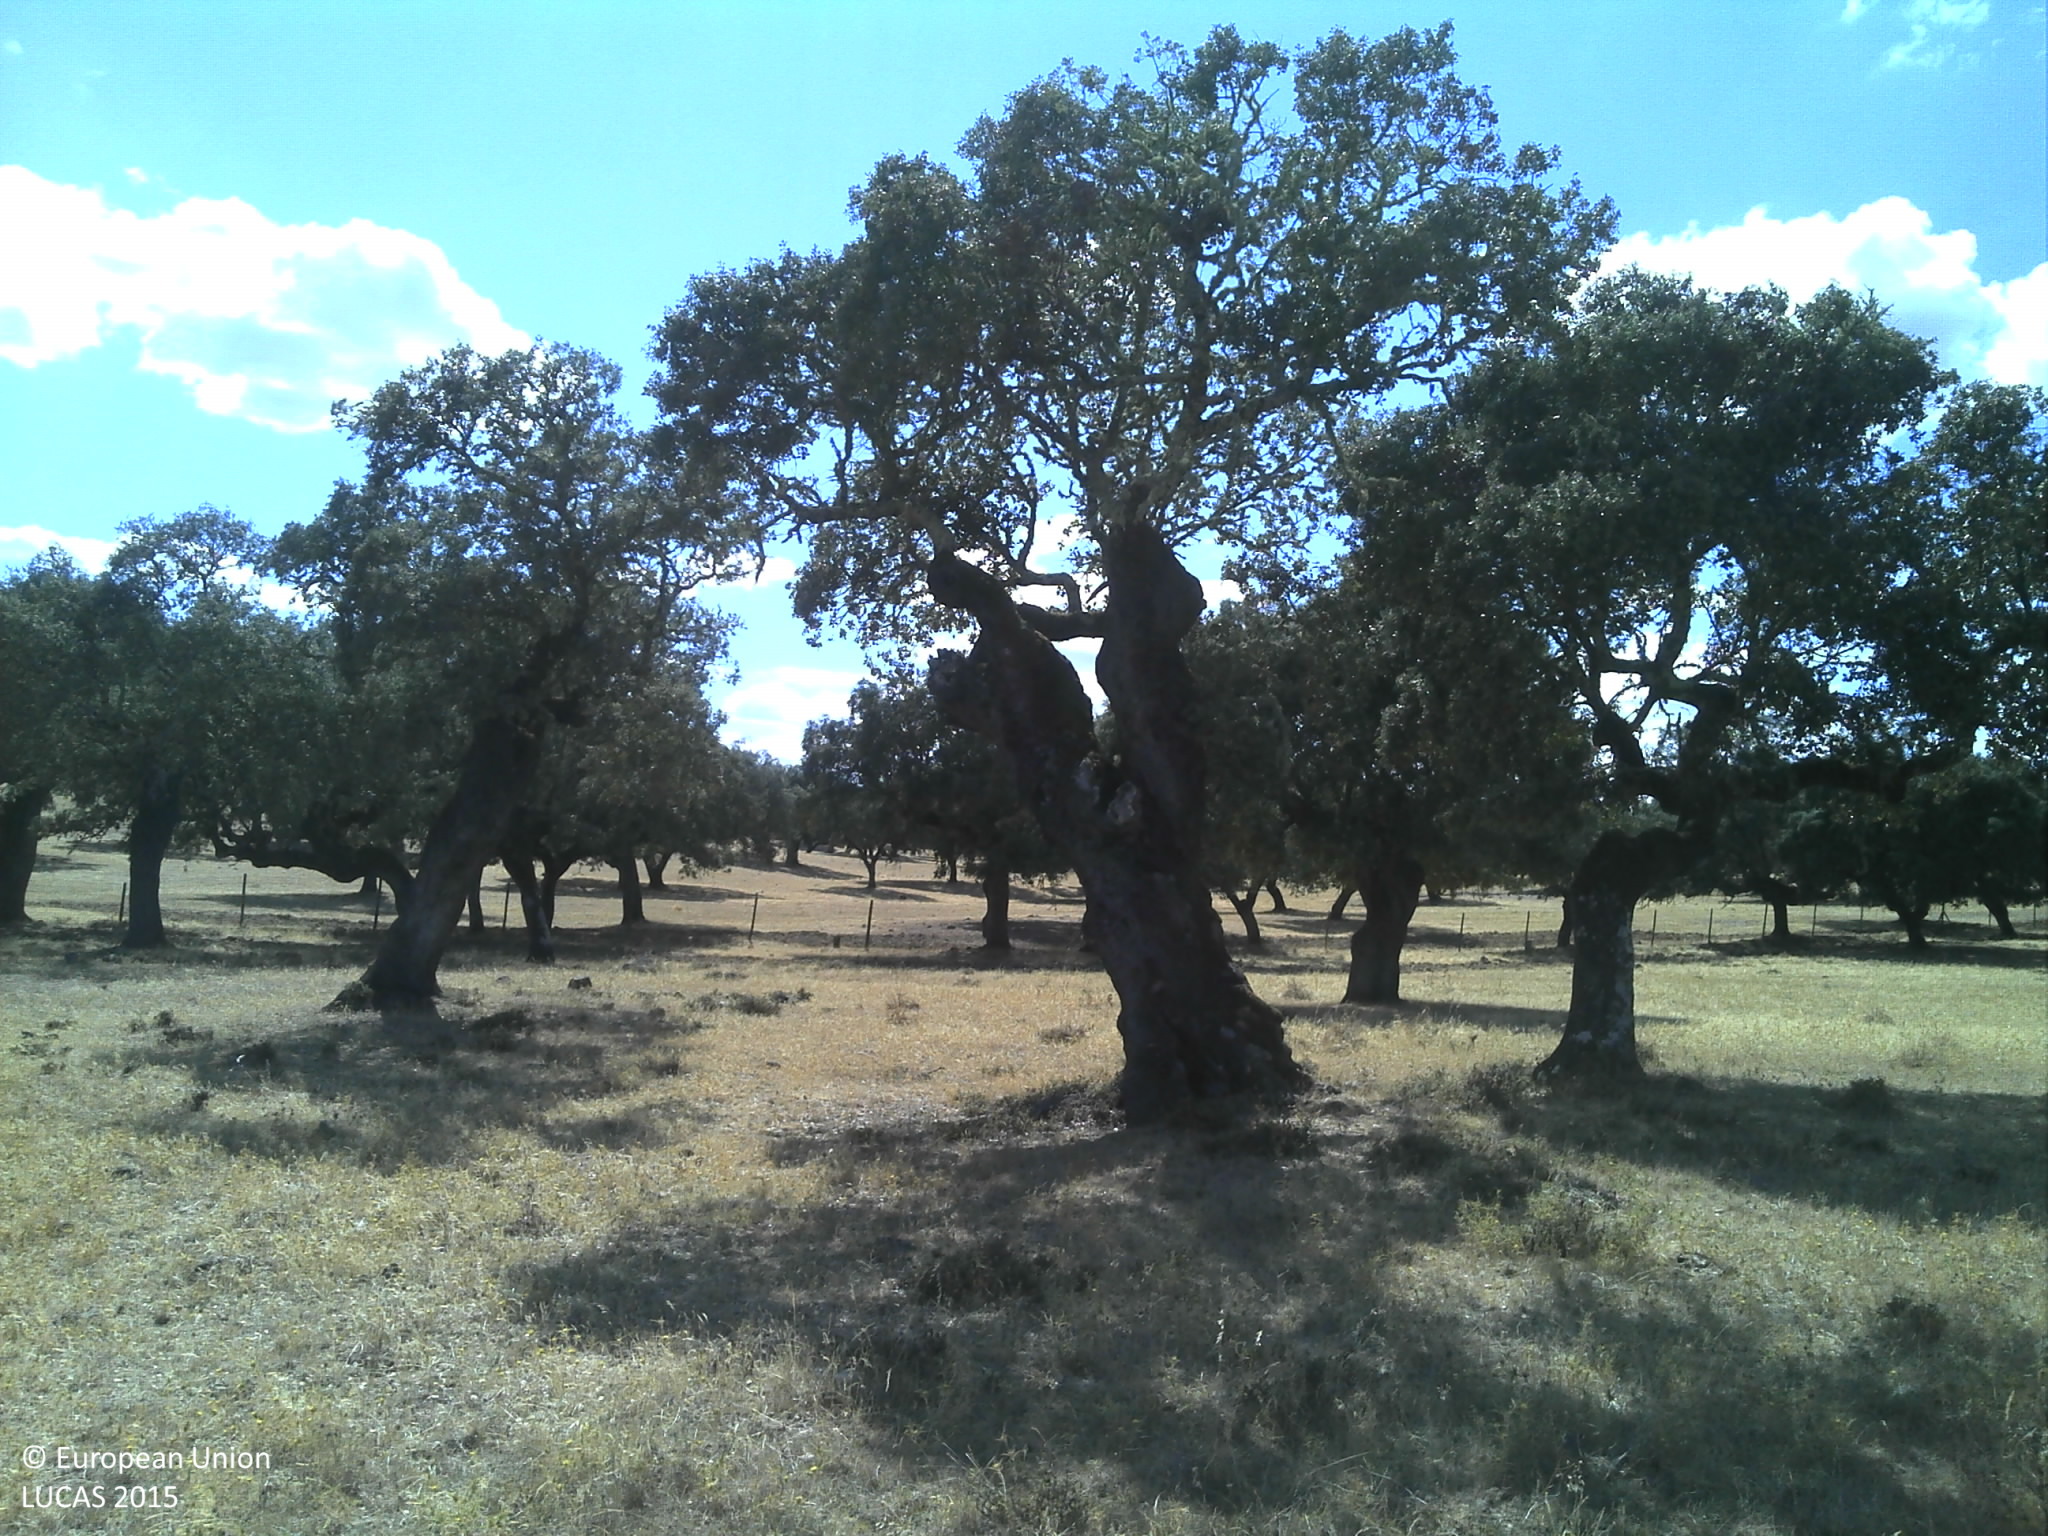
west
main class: Woodland
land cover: Broadleaved woodland
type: broadleaved evergreen forest
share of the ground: 10 - 25 %
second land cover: Grassland without tree/shrub cover
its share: 10 - 25 %
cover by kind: unconsolidated bare surface 70 %, broadleaved forest trees 15 %, herbaceous plants 15 %
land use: Forestry
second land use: Agriculture (excluding fallow land and kitchen gardens)
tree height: > 5 m
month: July
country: PT
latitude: 39.1599
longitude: -7.5041
